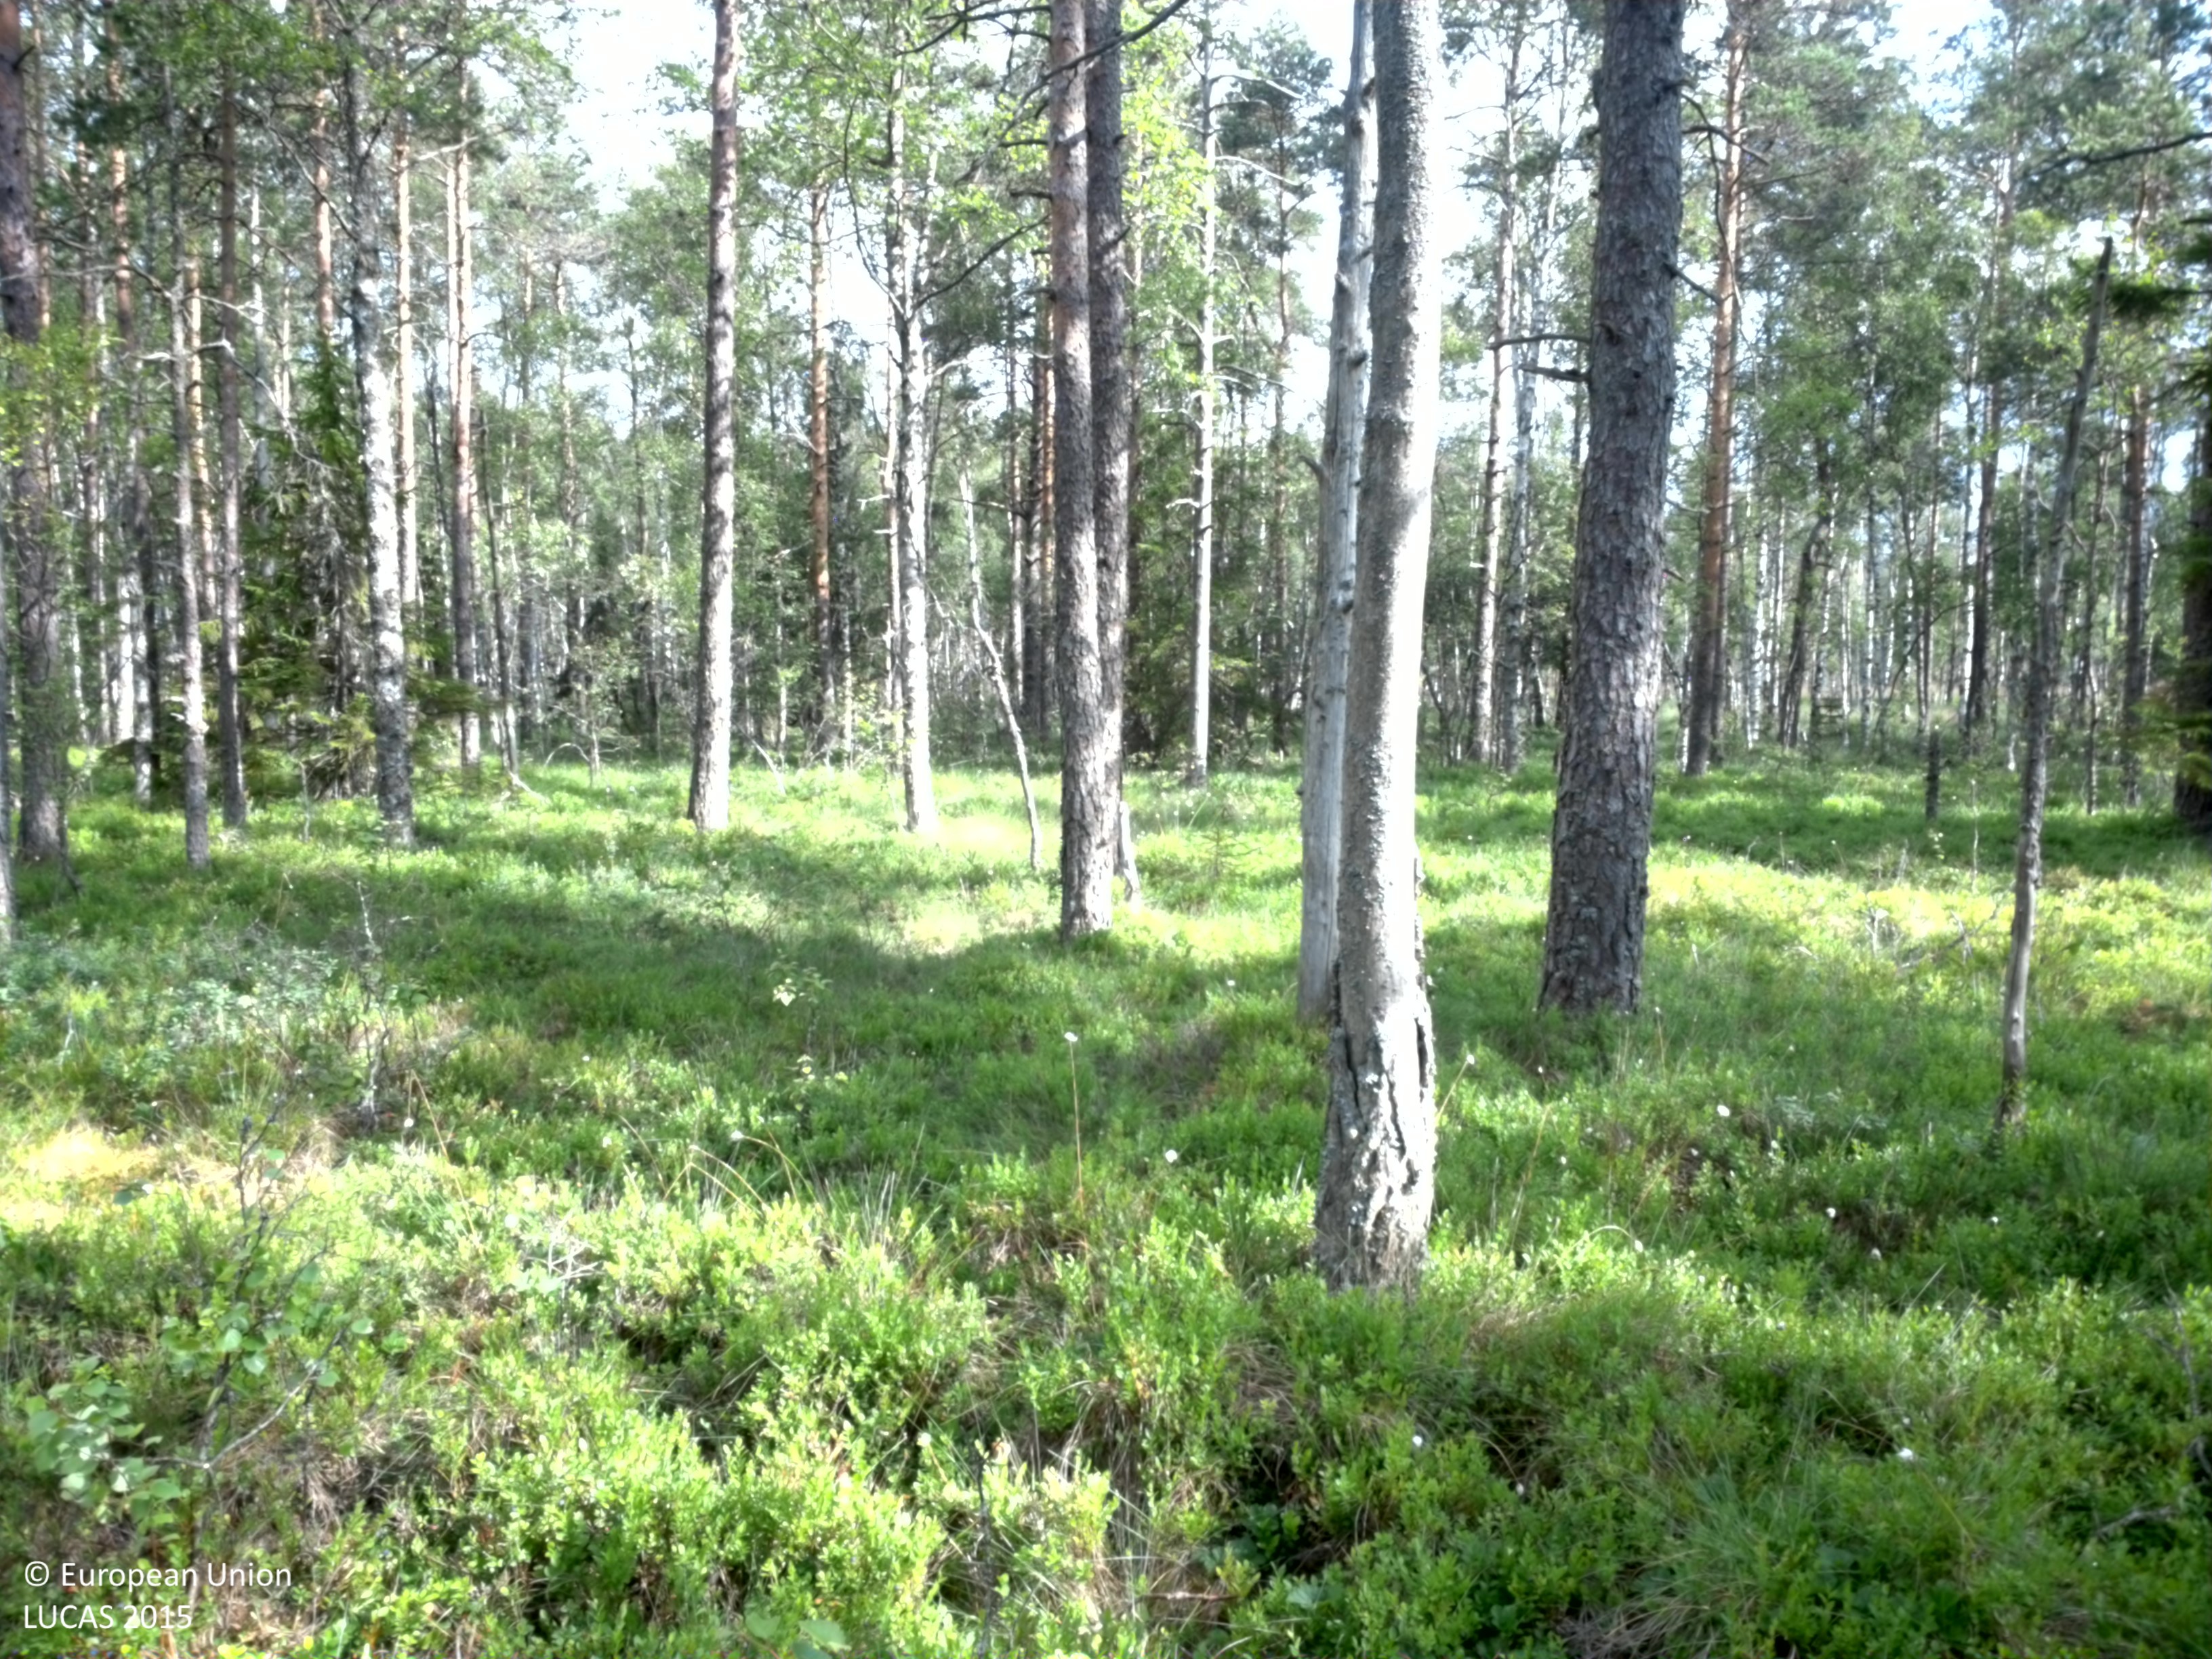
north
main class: Woodland
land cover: Pine dominated coniferous woodland
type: boreal forest
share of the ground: 50 - 75 %
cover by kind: coniferous forest trees 70 %, shrubs 15 %, lichens and mosses 15 %
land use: Forestry
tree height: > 5 m
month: July
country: SE
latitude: 57.5657
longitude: 14.5594
